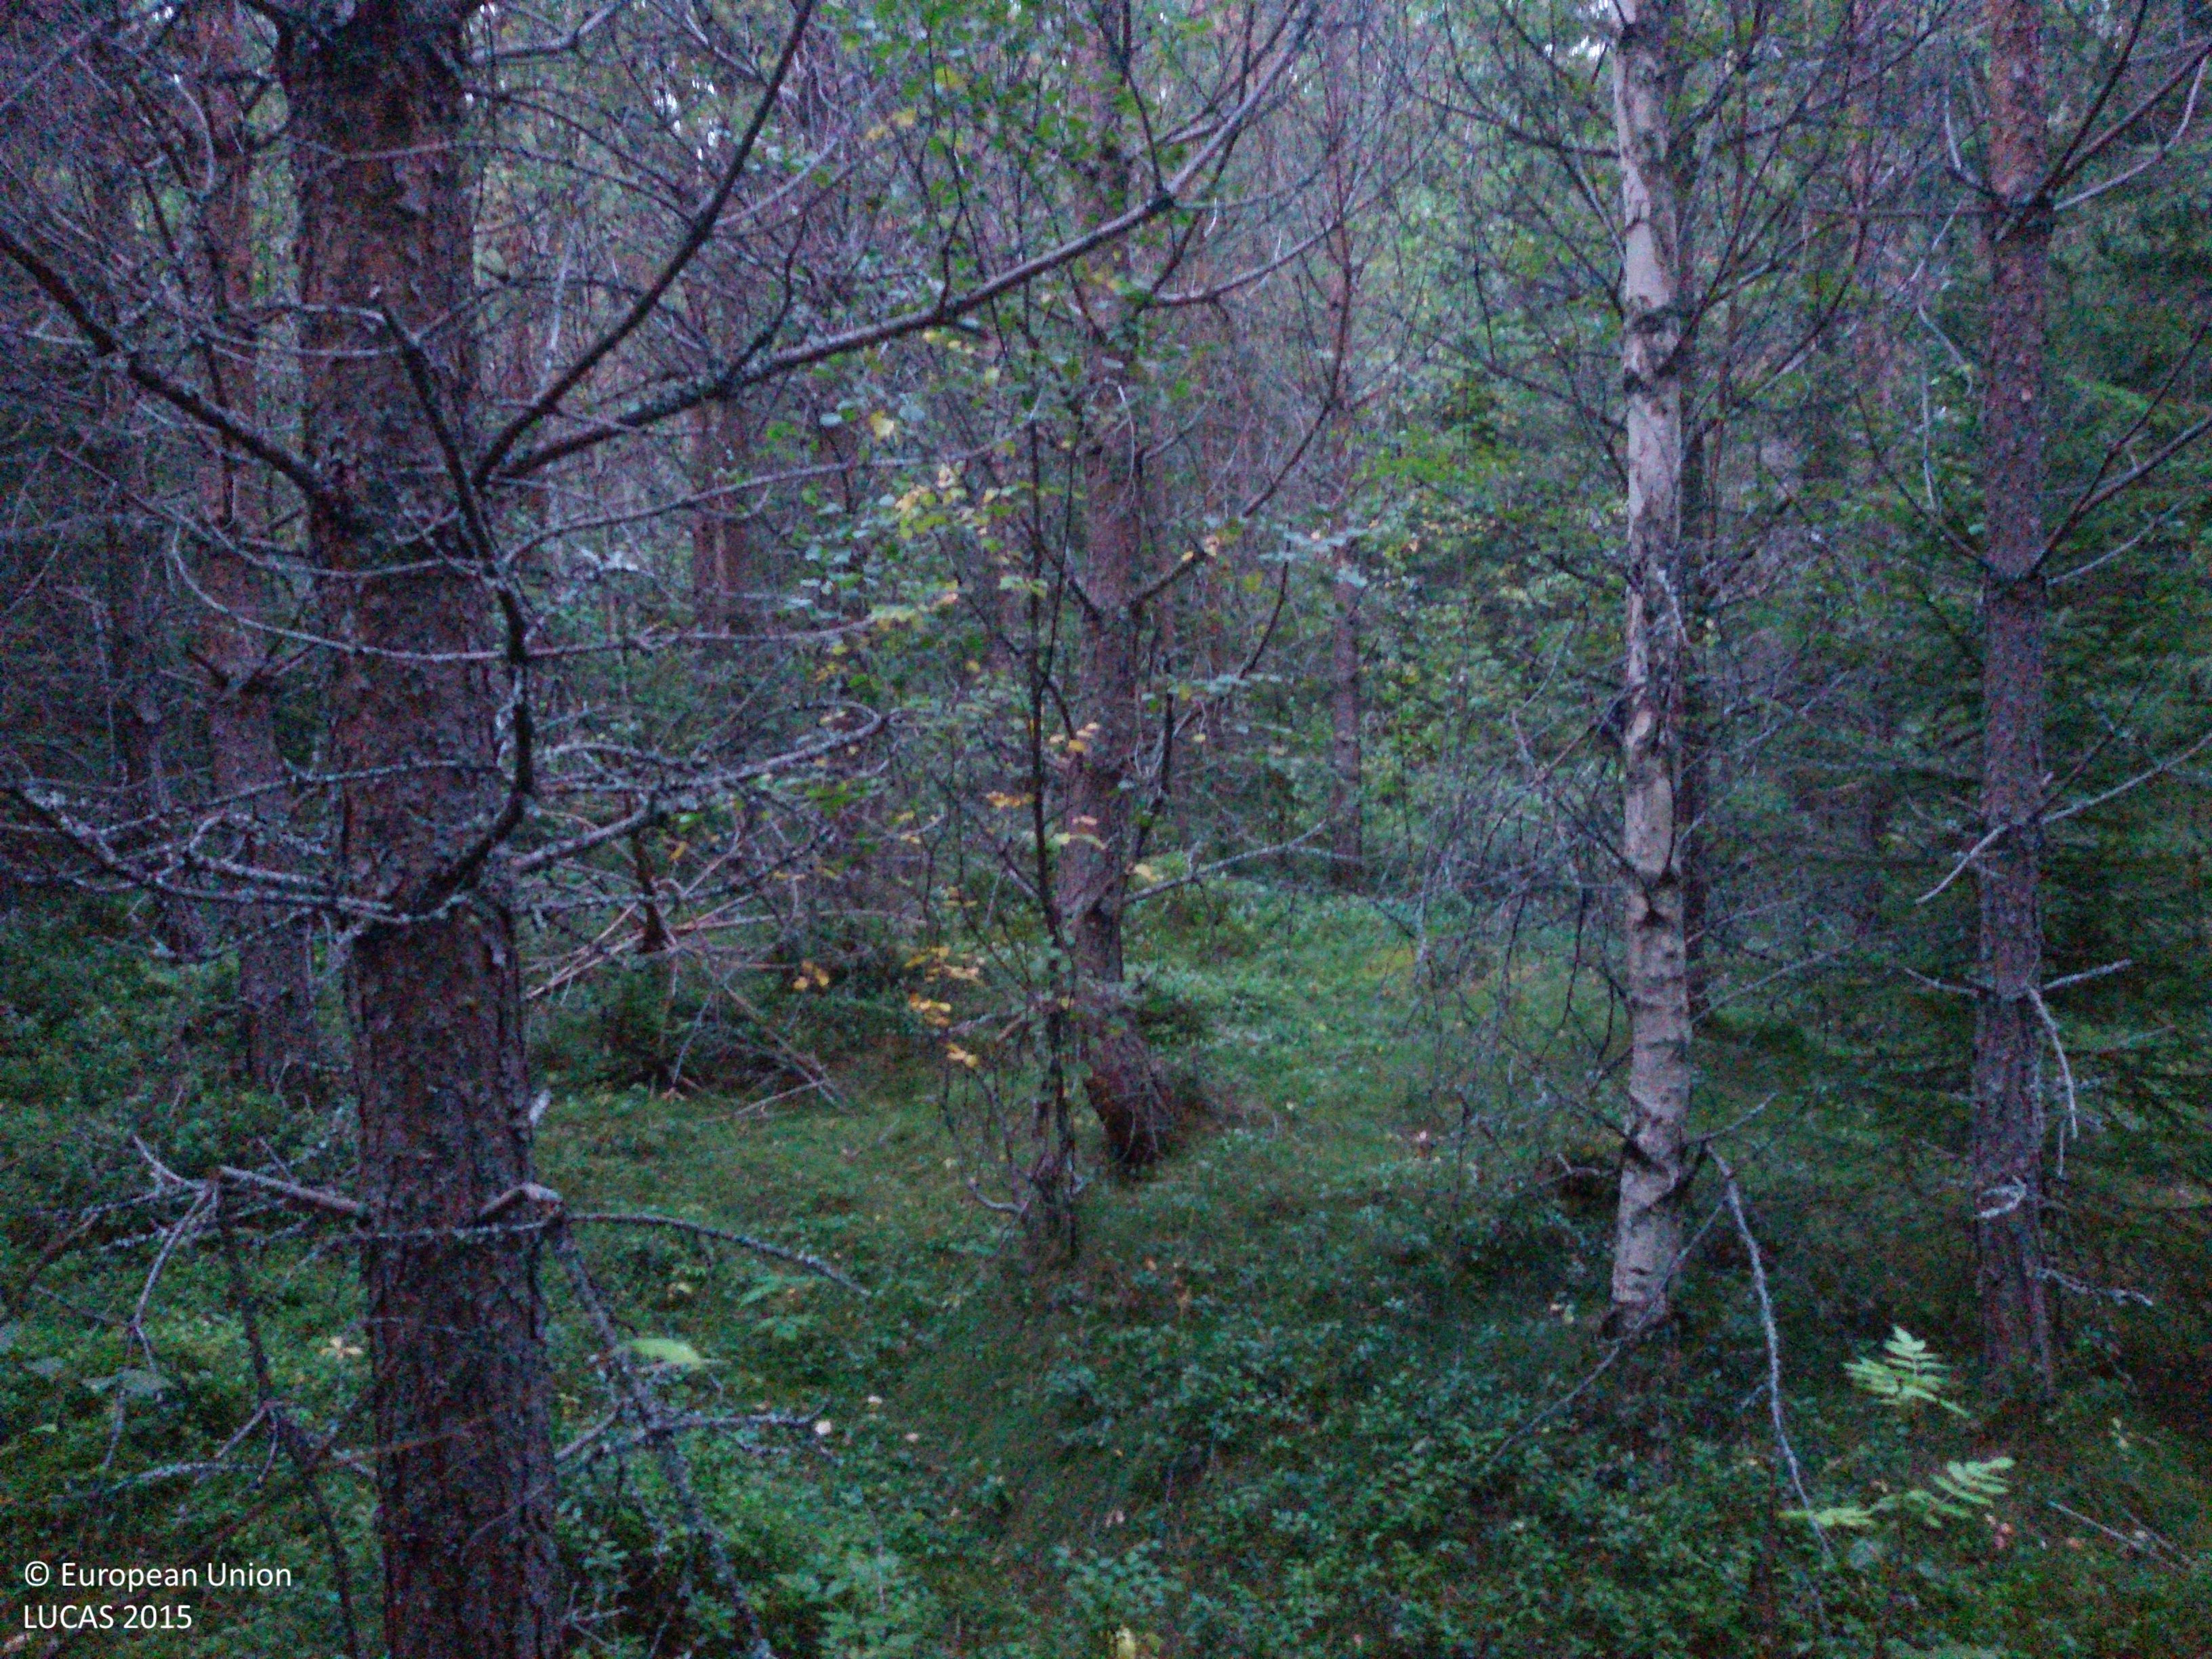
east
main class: Woodland
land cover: Pine dominated coniferous woodland
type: boreal forest
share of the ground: > 75 %
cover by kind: coniferous forest trees 80 %, shrubs 15 %, lichens and mosses 5 %
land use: Forestry
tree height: > 5 m
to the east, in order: Pine dominated coniferous woodland; Pine dominated mixed woodland; Pine dominated coniferous woodland; Spruce dominated mixed woodland; Broadleaved woodland
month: September
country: SE
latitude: 60.7148
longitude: 15.2468
